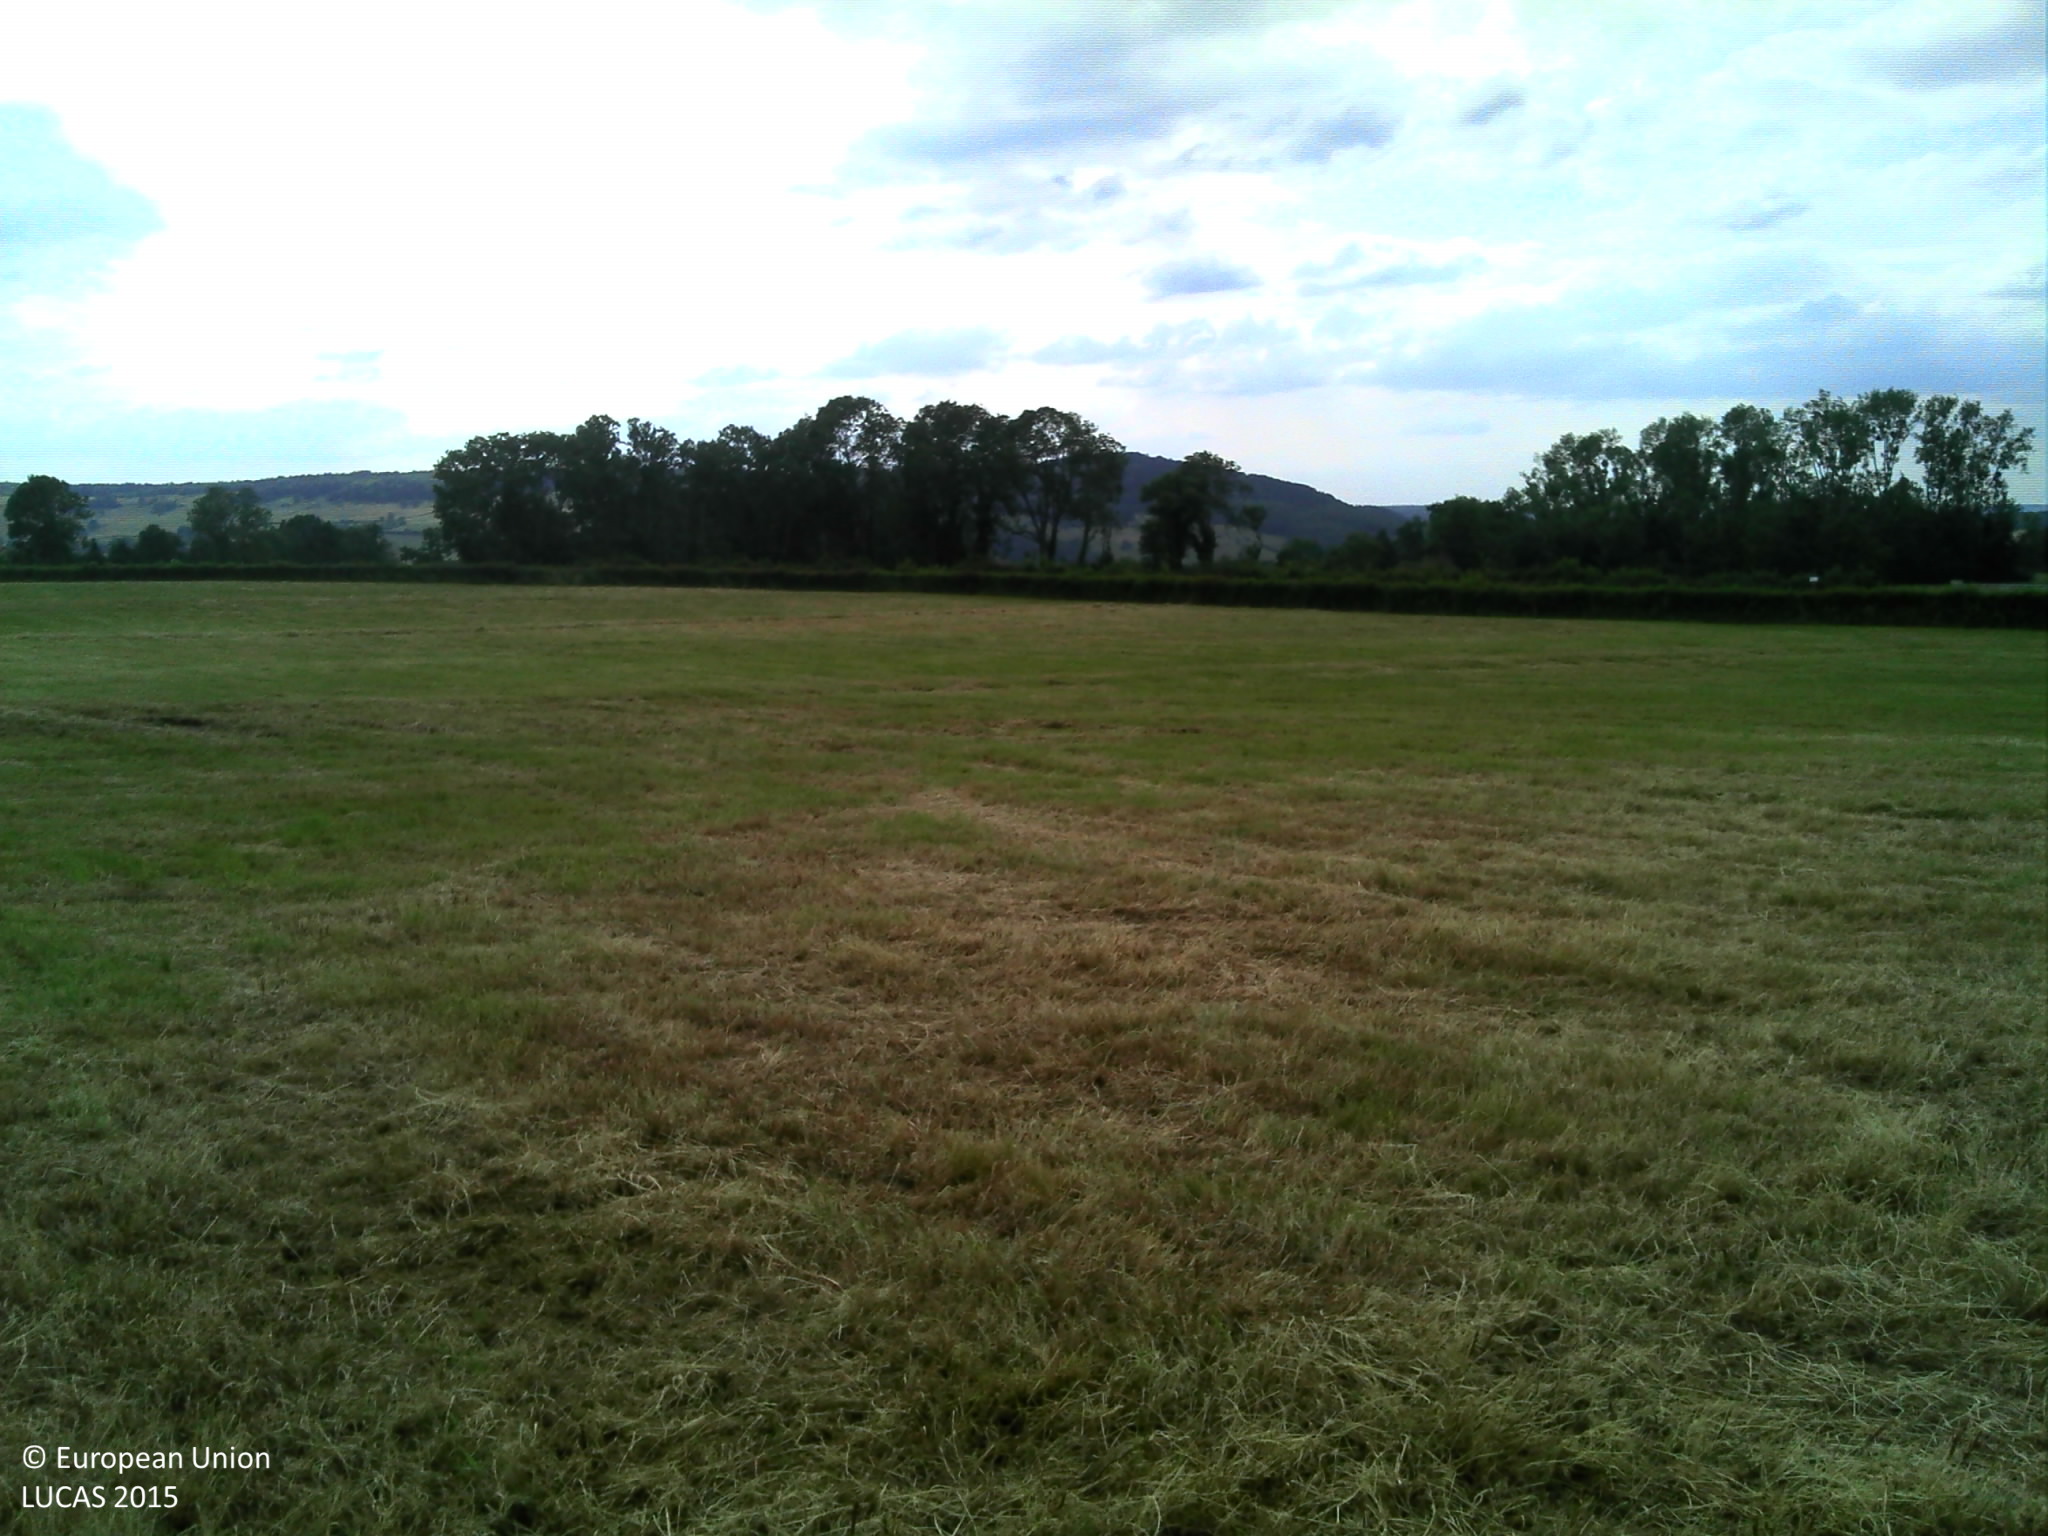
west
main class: Grassland
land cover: Grassland without tree/shrub cover
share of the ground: > 75 %
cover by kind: herbaceous plants 100 %
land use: Agriculture (excluding fallow land and kitchen gardens)
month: June
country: FR
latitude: 47.4939
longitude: 3.8783
